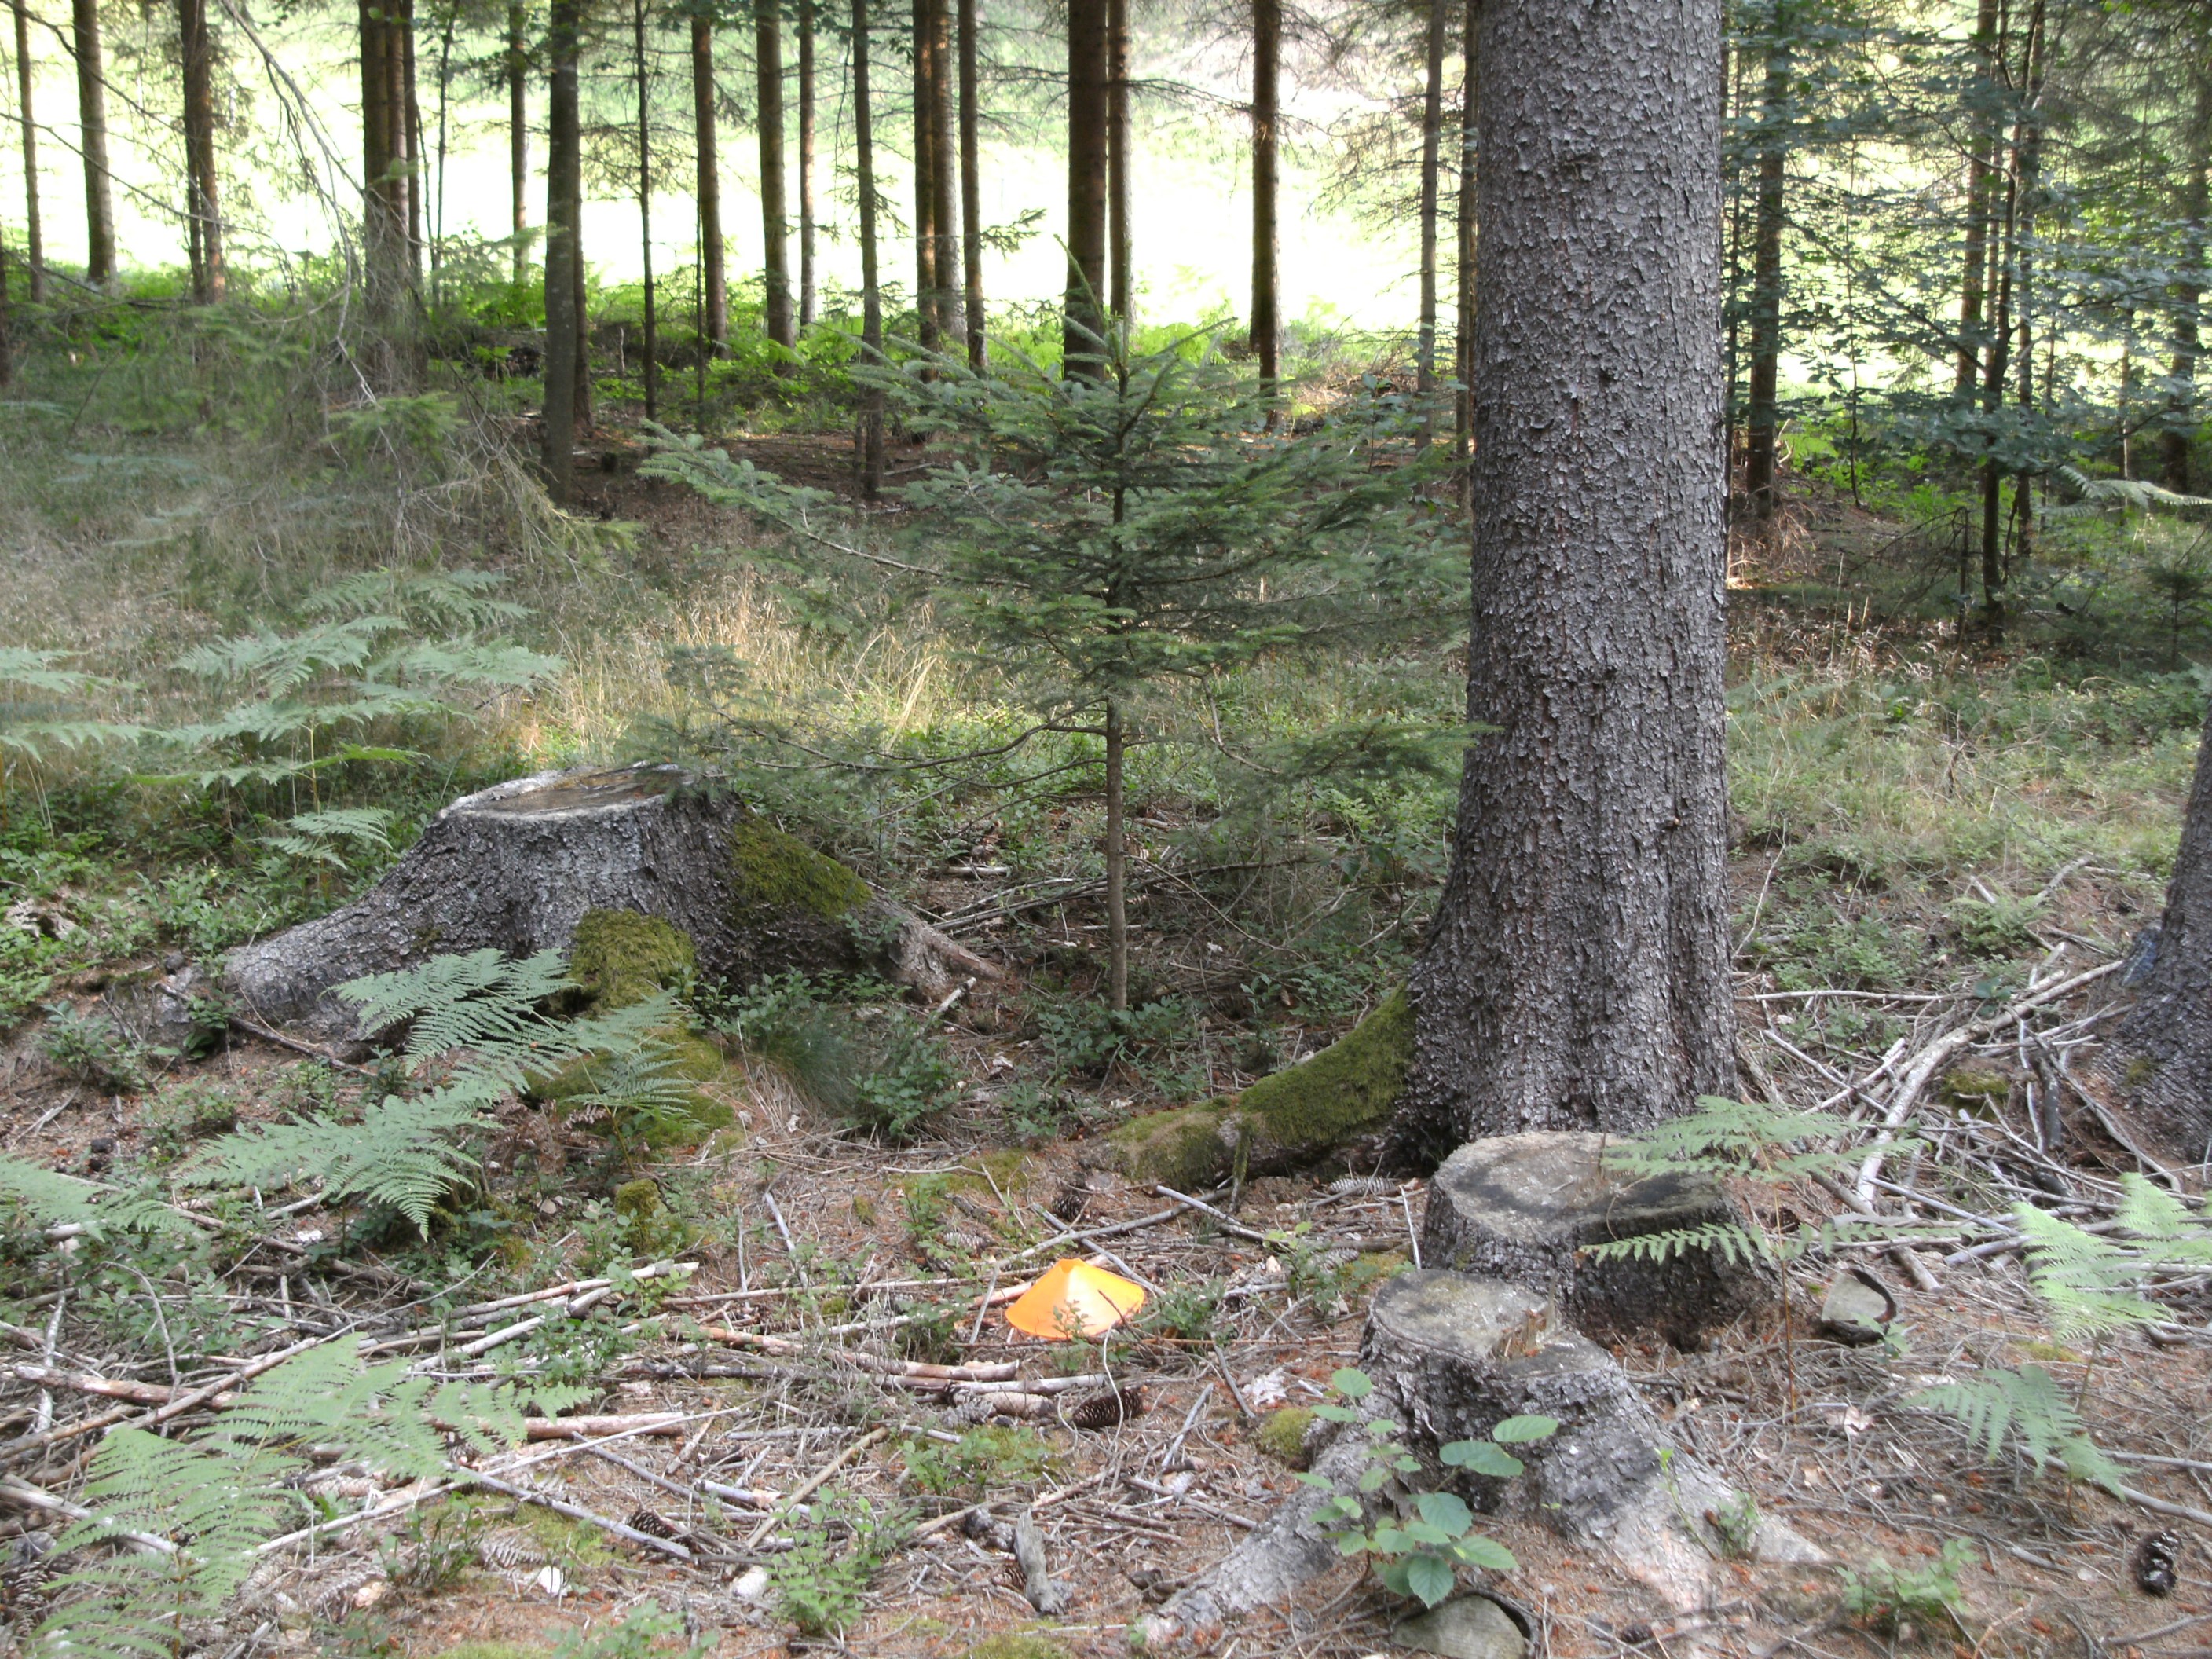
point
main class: Woodland
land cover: Spruce dominated coniferous woodland
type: hemiboreal forest and nemoral coniferous forest and mixed broadleaved-coniferous forest
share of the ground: 25 - 50 %
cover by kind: coniferous forest trees 45 %, shrubs 15 %, herbaceous plants 15 %, unconsolidated bare surface 15 %, broadleaved forest trees 5 %, lichens and mosses 5 %
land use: Forestry
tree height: > 5 m
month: July
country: AT
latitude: 46.7426
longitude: 14.9327
